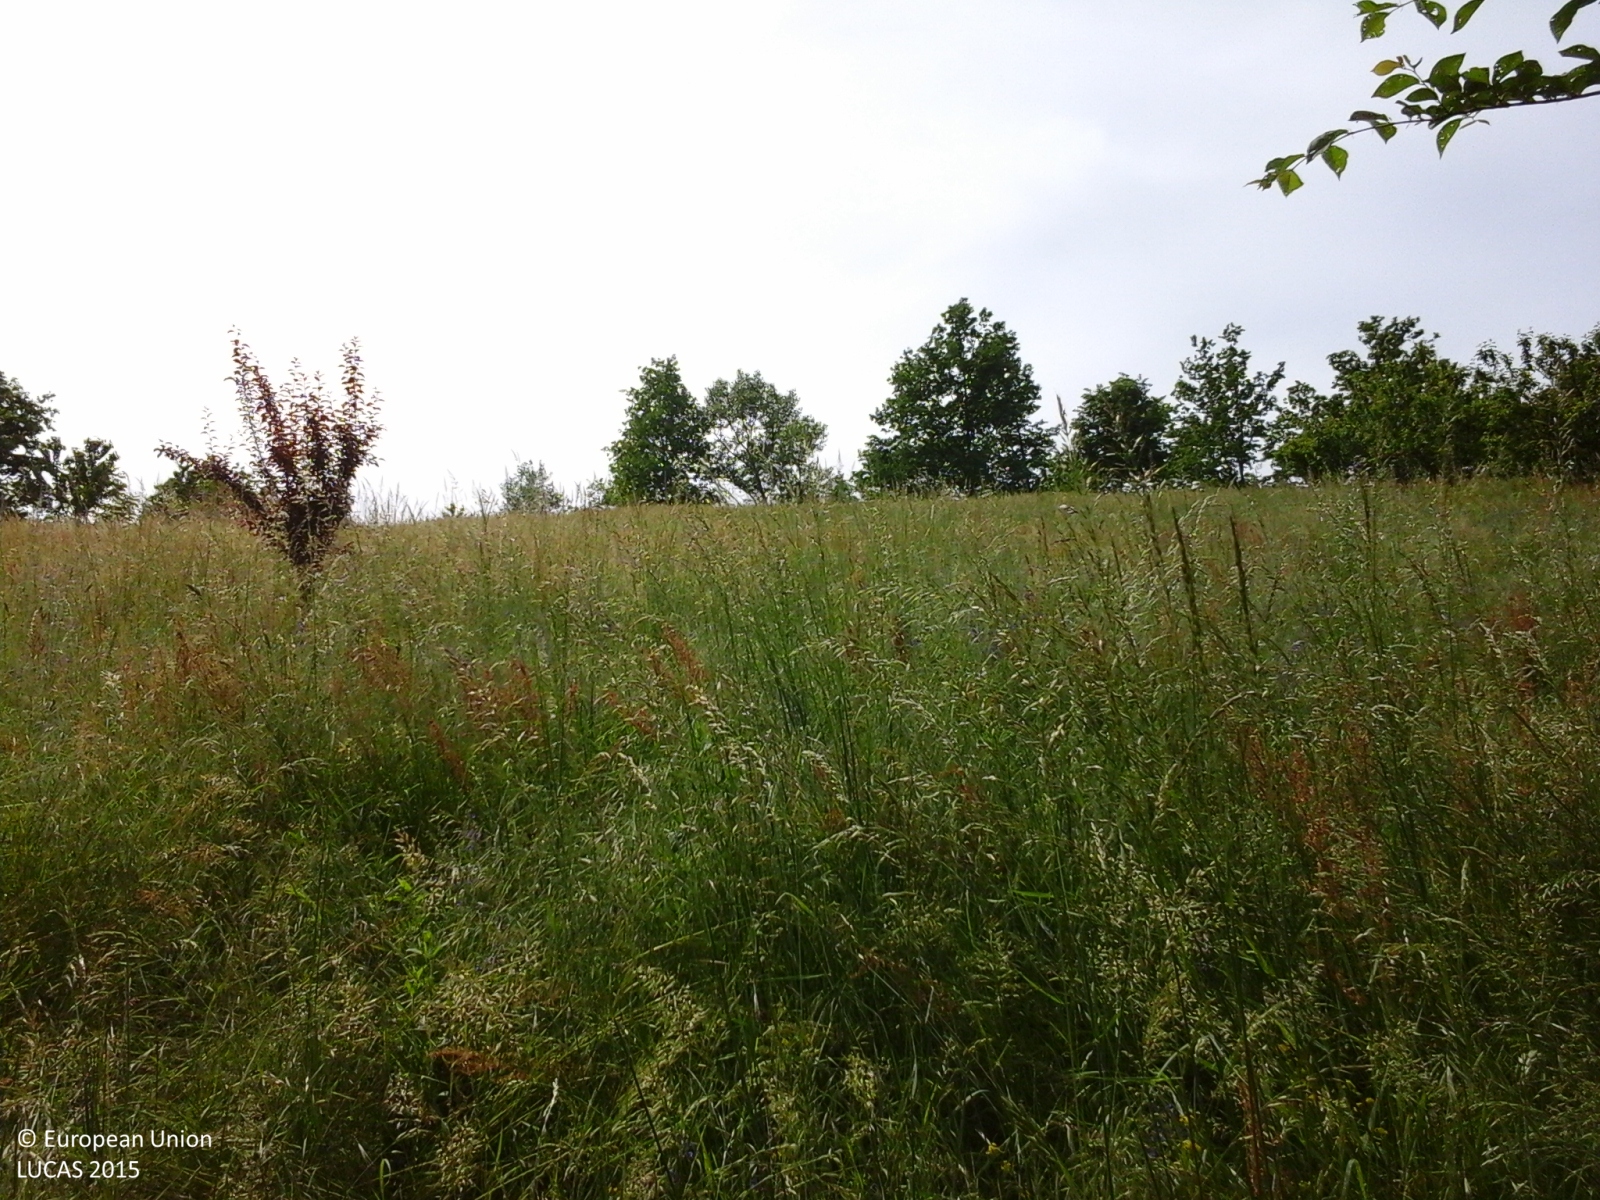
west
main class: Grassland
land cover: Grassland with sparse tree/shrub cover
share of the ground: > 75 %
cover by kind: herbaceous plants 85 %, shrubs 10 %, broadleaved forest trees 5 %
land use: Agriculture (excluding fallow land and kitchen gardens)
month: May
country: IT
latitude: 44.9128
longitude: 8.2427
